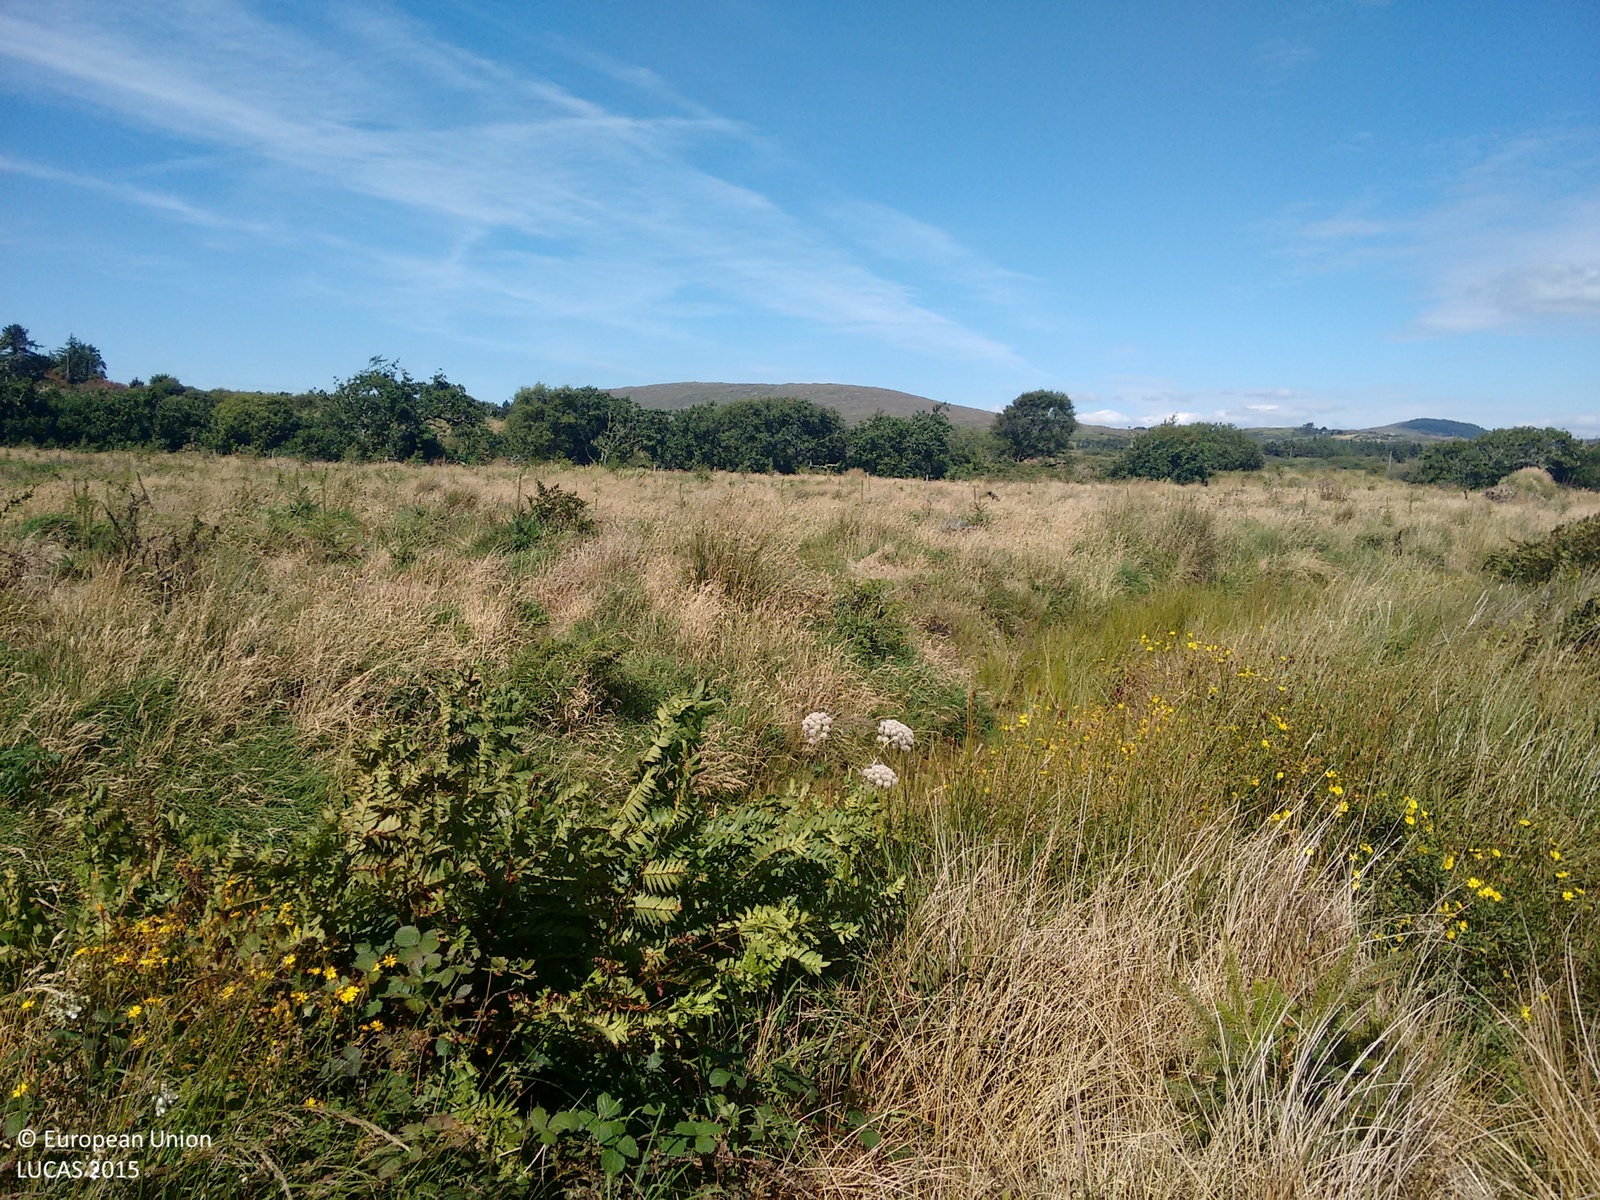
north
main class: Woodland
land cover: Spruce dominated coniferous woodland
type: exotic forest
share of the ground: > 75 %
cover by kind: coniferous forest trees 50 %, herbaceous plants 50 %
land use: Forestry
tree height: < 5 m
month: August
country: IE
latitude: 51.5664
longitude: -9.5219
